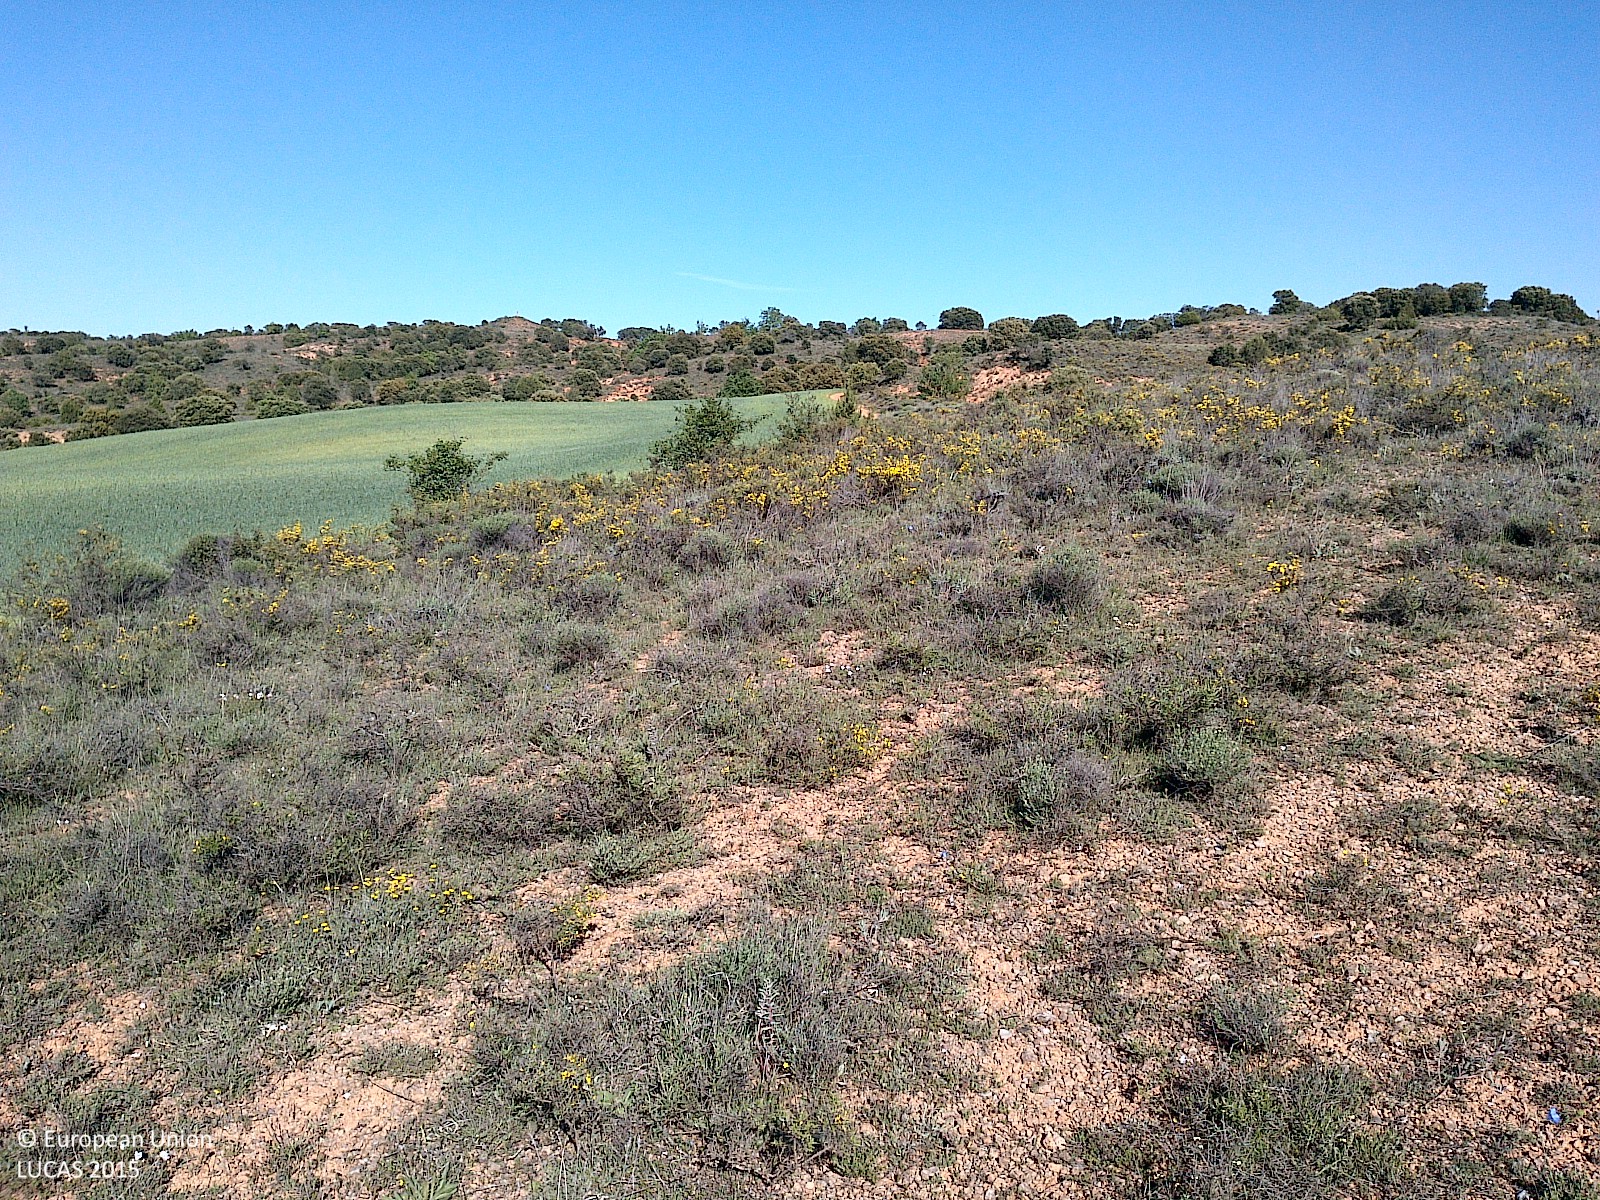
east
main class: Shrubland
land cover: Shrubland without tree cover
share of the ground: 50 - 75 %
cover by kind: shrubs 65 %, herbaceous plants 20 %, consolidated bare surface 15 %
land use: Semi-natural and natural areas not in use
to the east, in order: Shrubland without tree cover; Common wheat; Abandoned hedges; Shrubland with sparse tree cover
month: May
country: ES
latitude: 41.6230
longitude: -3.1877
